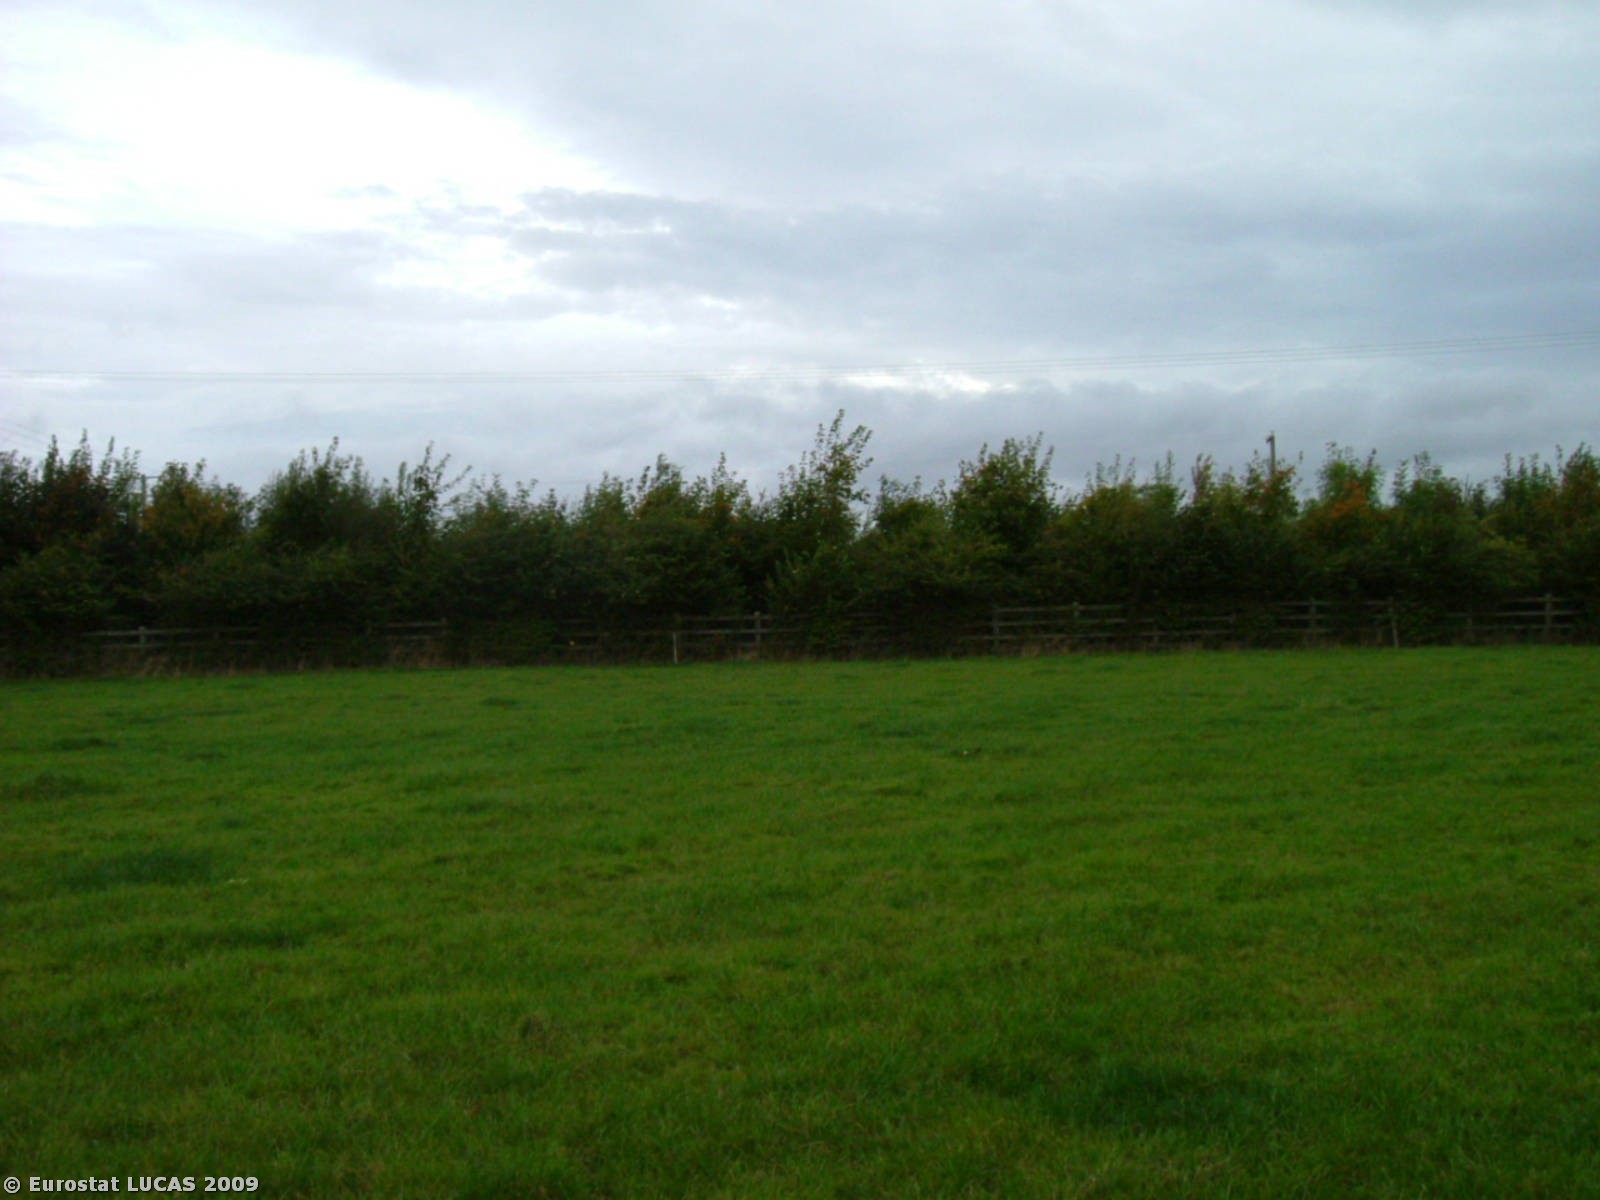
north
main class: Grassland
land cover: Grassland without tree/shrub cover
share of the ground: > 75 %
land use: Agriculture (excluding fallow land and kitchen gardens)
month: September
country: IE
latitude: 52.8677
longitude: -8.2331
